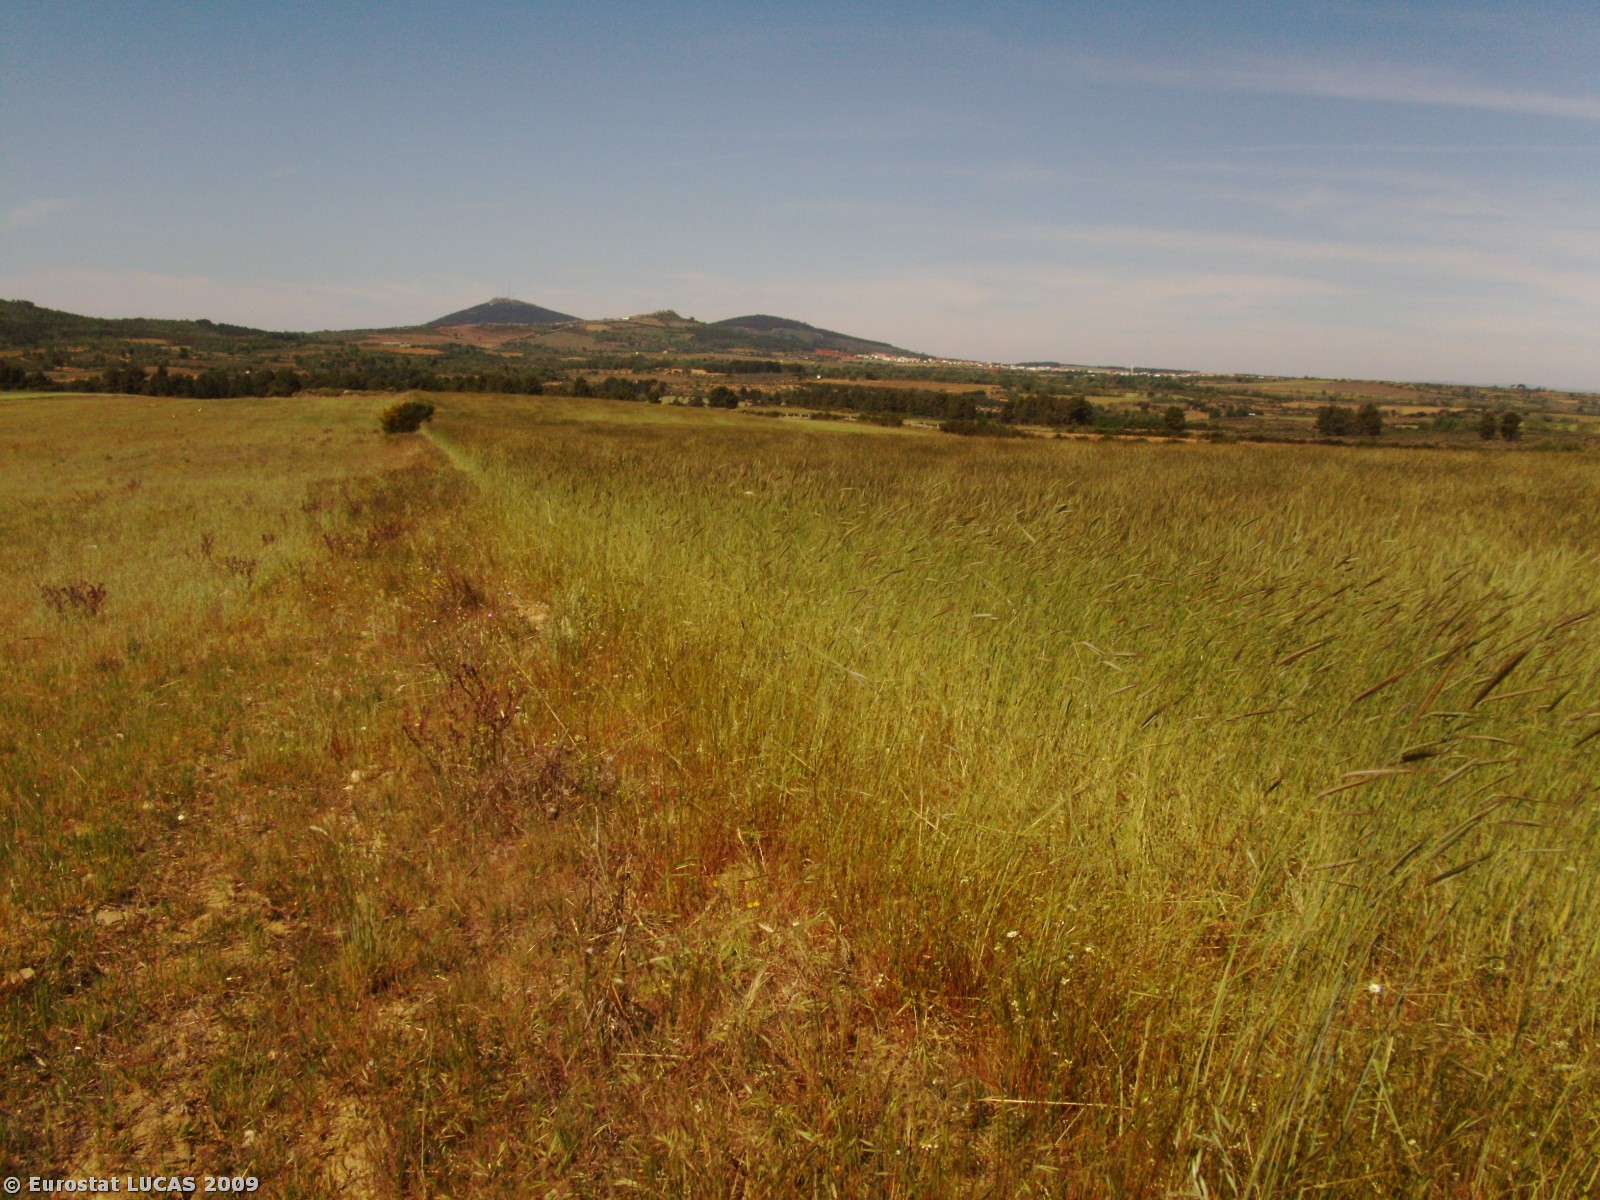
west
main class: Cropland
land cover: Rye
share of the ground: > 75 %
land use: Agriculture (excluding fallow land and kitchen gardens)
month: May
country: PT
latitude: 40.8907
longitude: -6.8972
